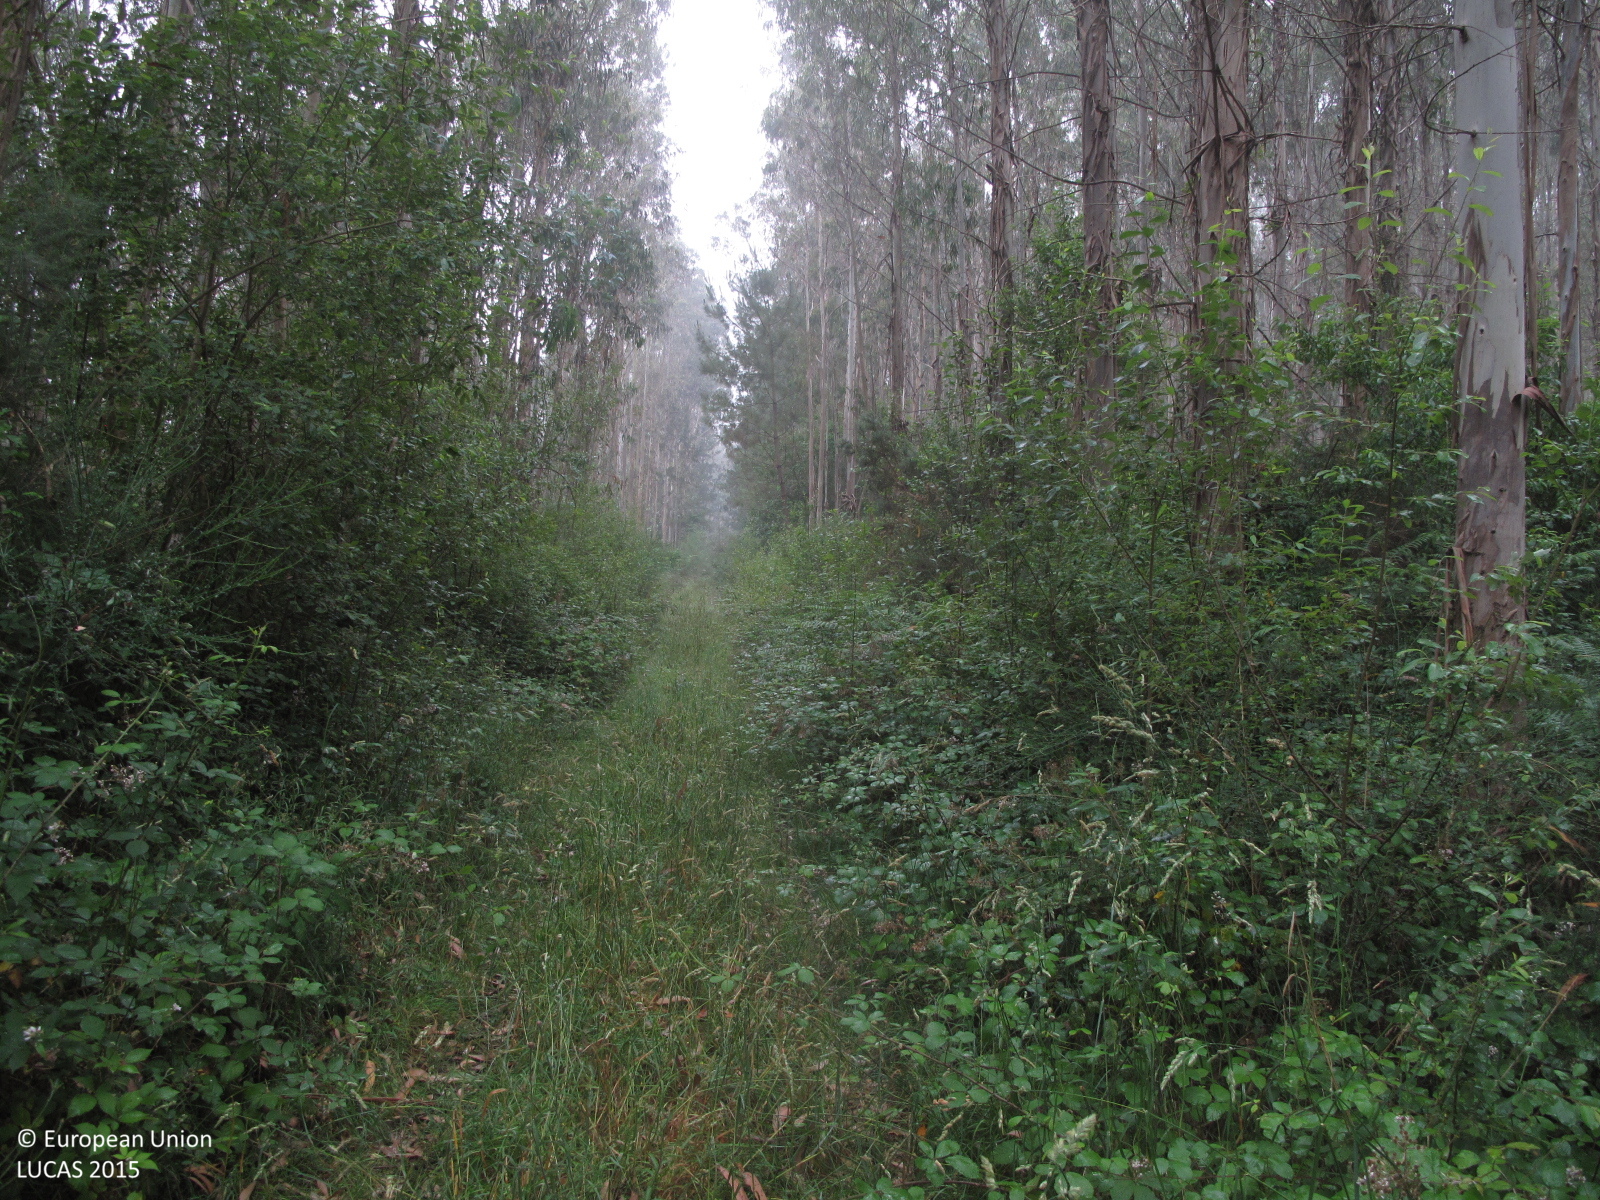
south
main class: Woodland
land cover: Broadleaved woodland
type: exotic forest
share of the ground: 50 - 75 %
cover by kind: broadleaved forest trees 70 %, shrubs 20 %, herbaceous plants 10 %
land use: Forestry
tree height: > 5 m
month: June
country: ES
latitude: 43.1992
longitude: -8.2268
